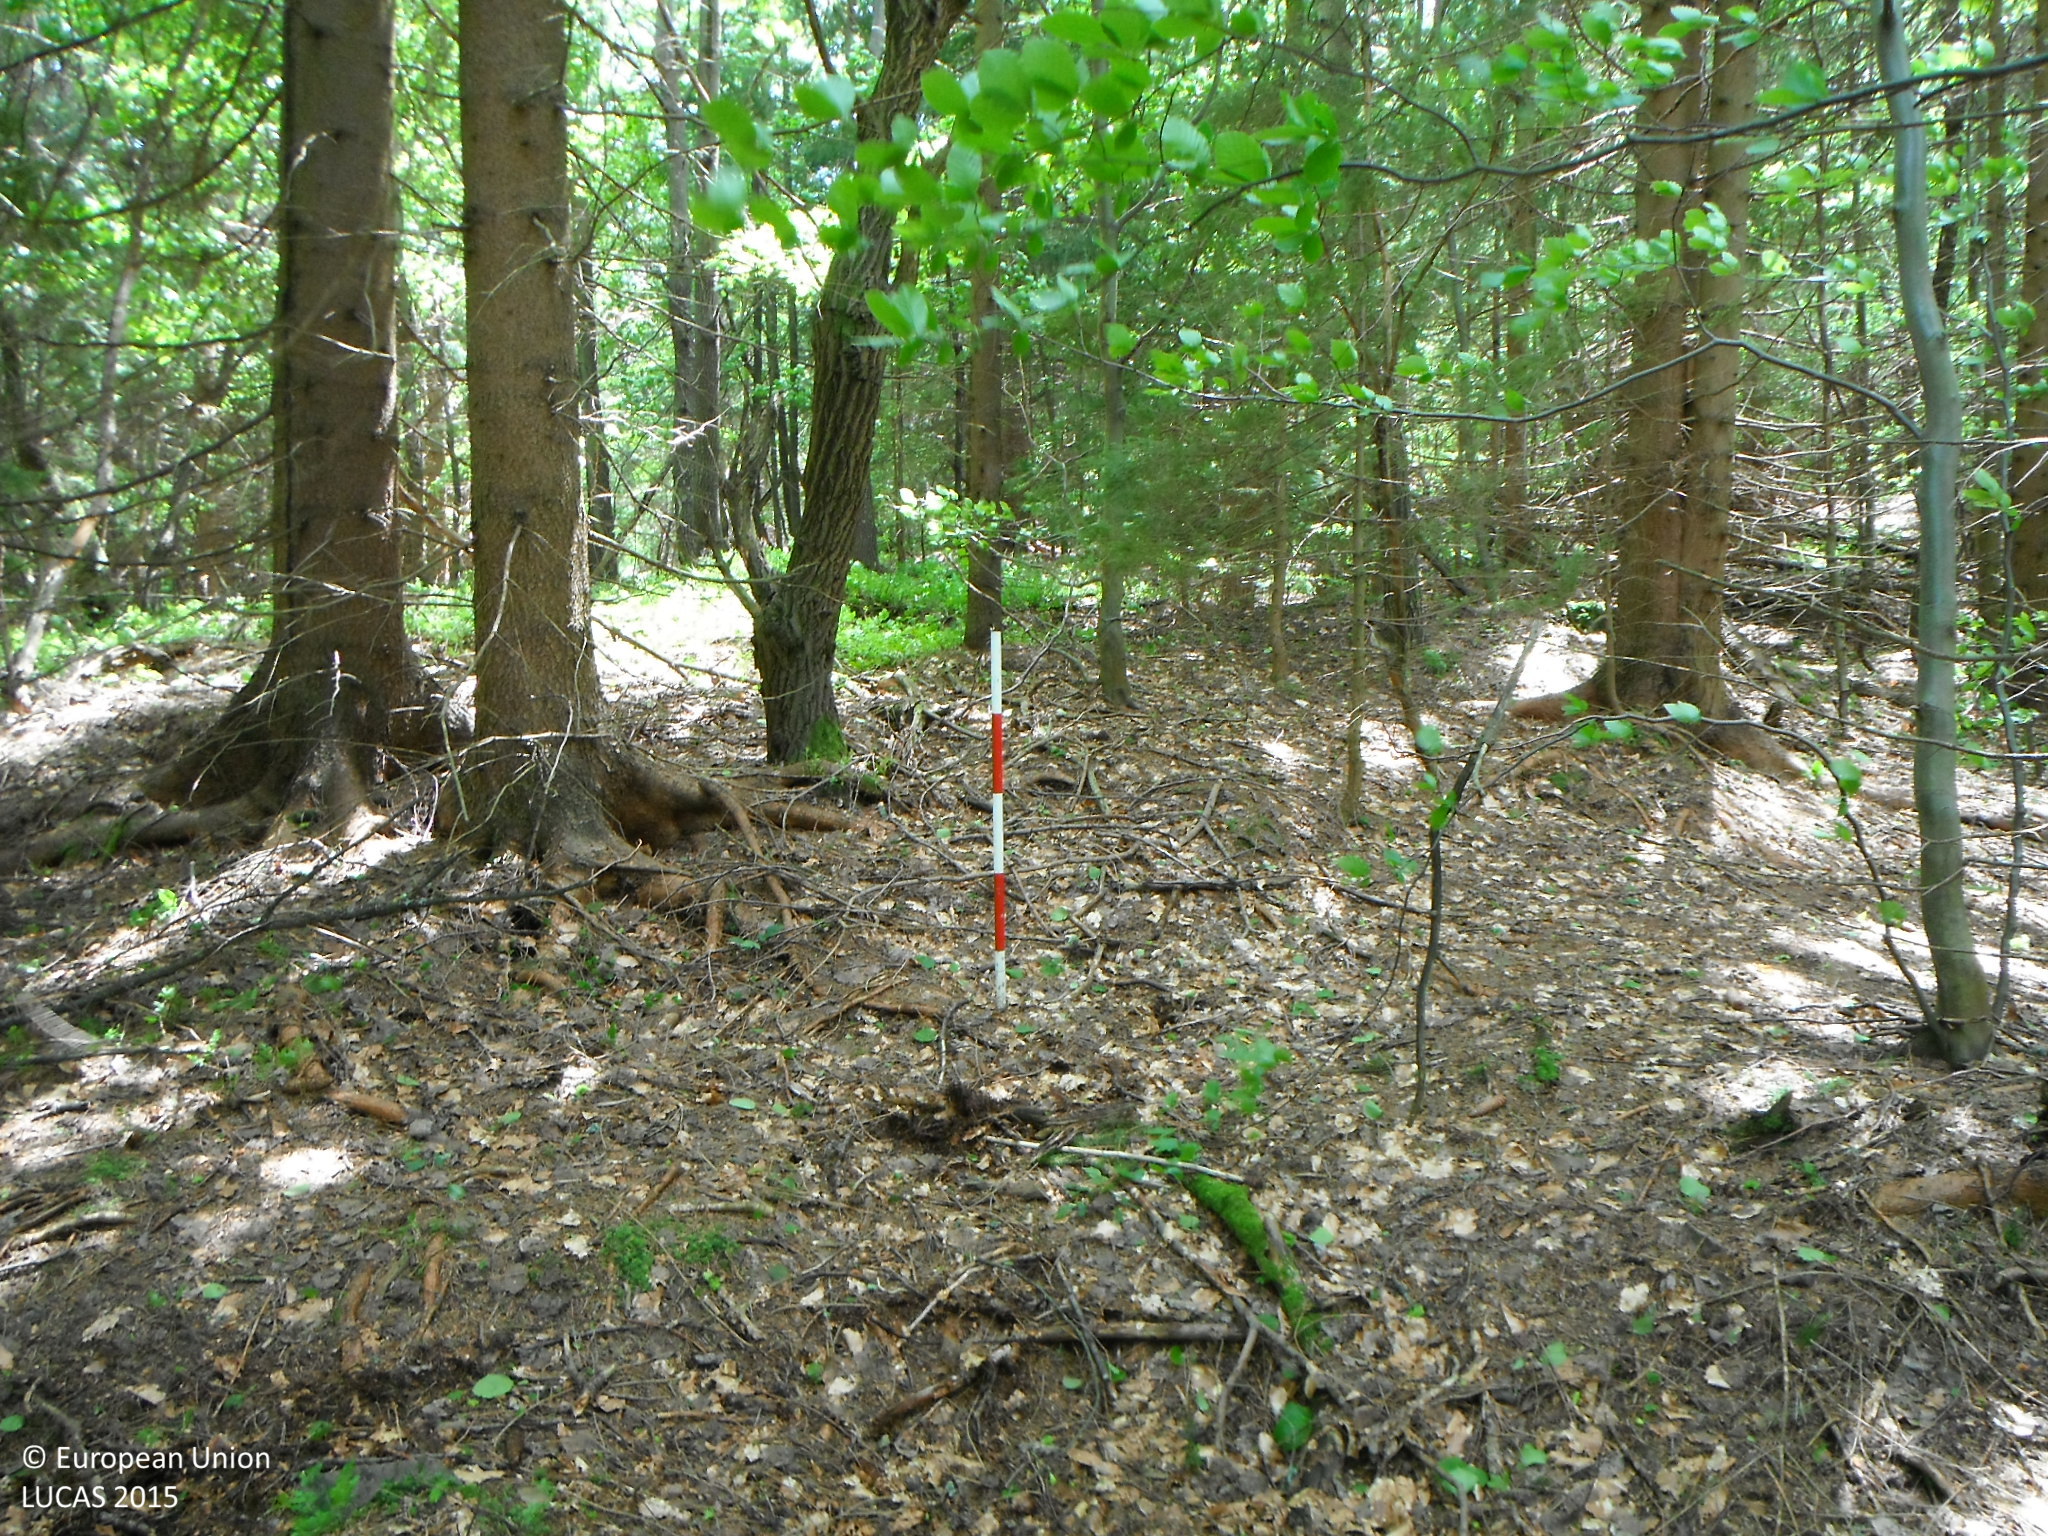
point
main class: Woodland
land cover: Spruce dominated mixed woodland
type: hemiboreal forest and nemoral coniferous forest and mixed broadleaved-coniferous forest
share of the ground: > 75 %
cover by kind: coniferous forest trees 70 %, broadleaved forest trees 30 %
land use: Forestry
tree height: > 5 m
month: May
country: SK
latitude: 48.8325
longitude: 19.2187
